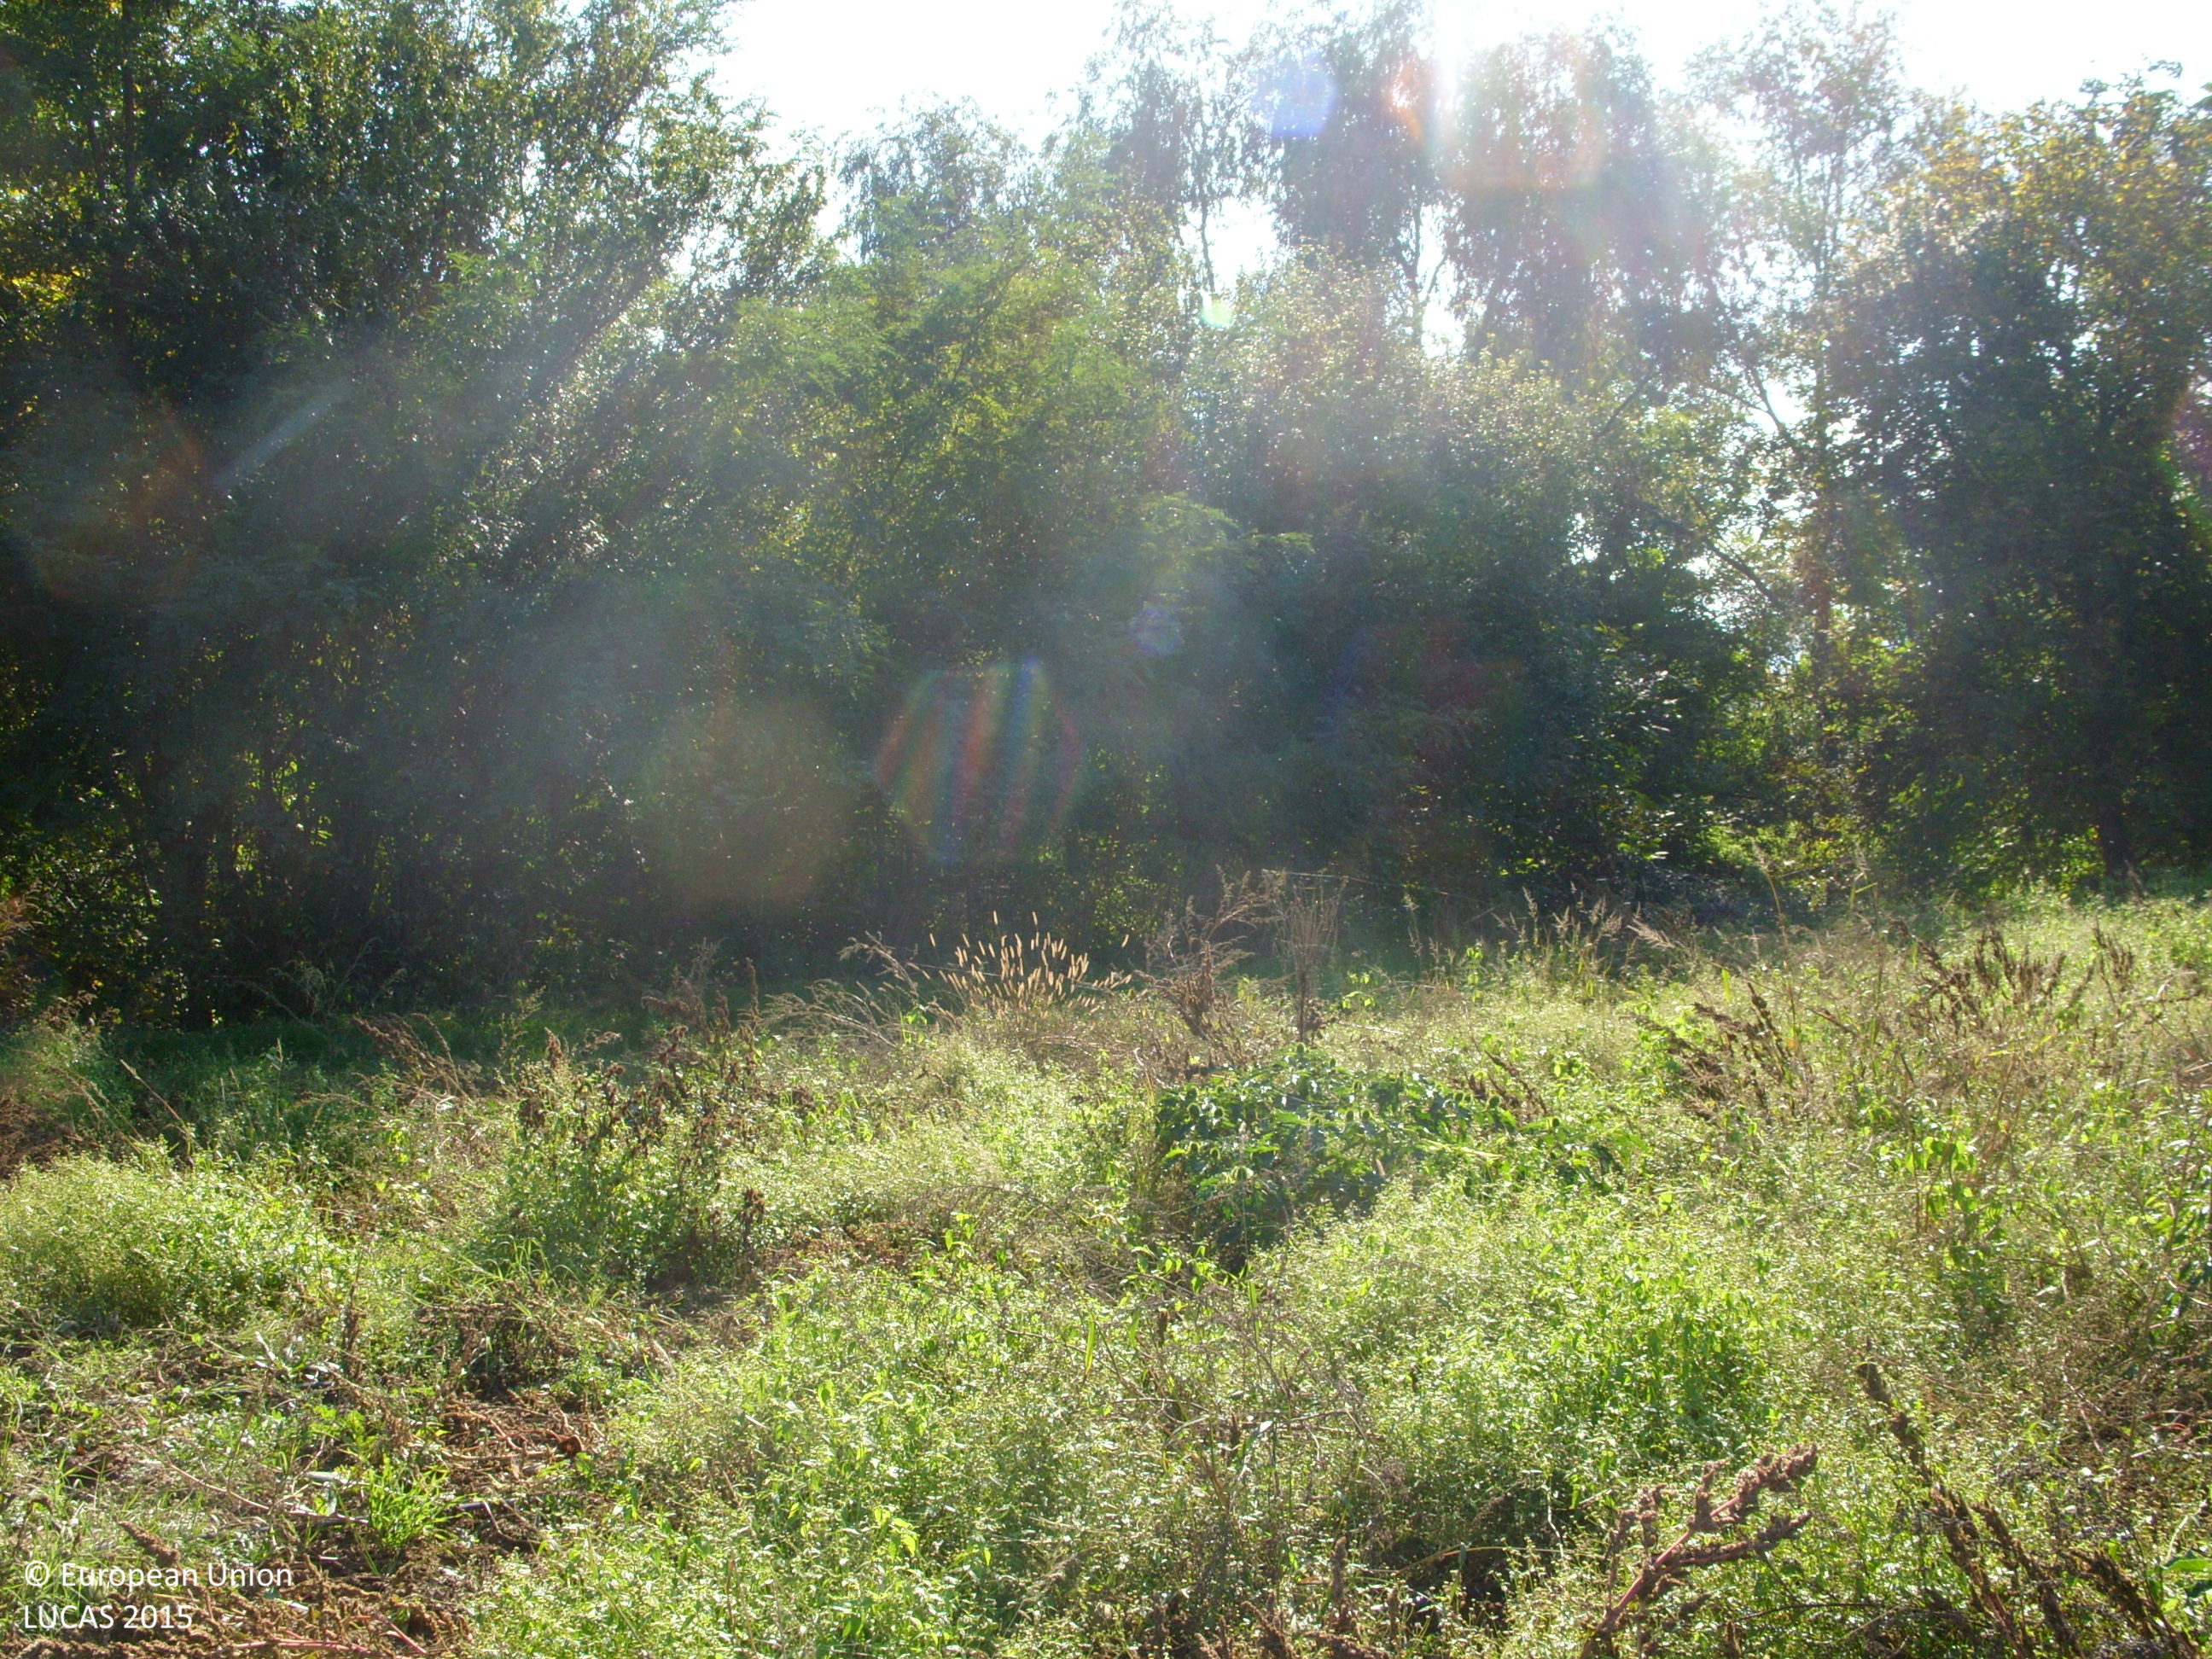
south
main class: Cropland
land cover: Other fresh vegetables
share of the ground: 25 - 50 %
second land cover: Spontaneously vegetated surfaces
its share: 50 - 75 %
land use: Agriculture (excluding fallow land and kitchen gardens)
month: October
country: BG
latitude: 42.6018
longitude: 24.6938
